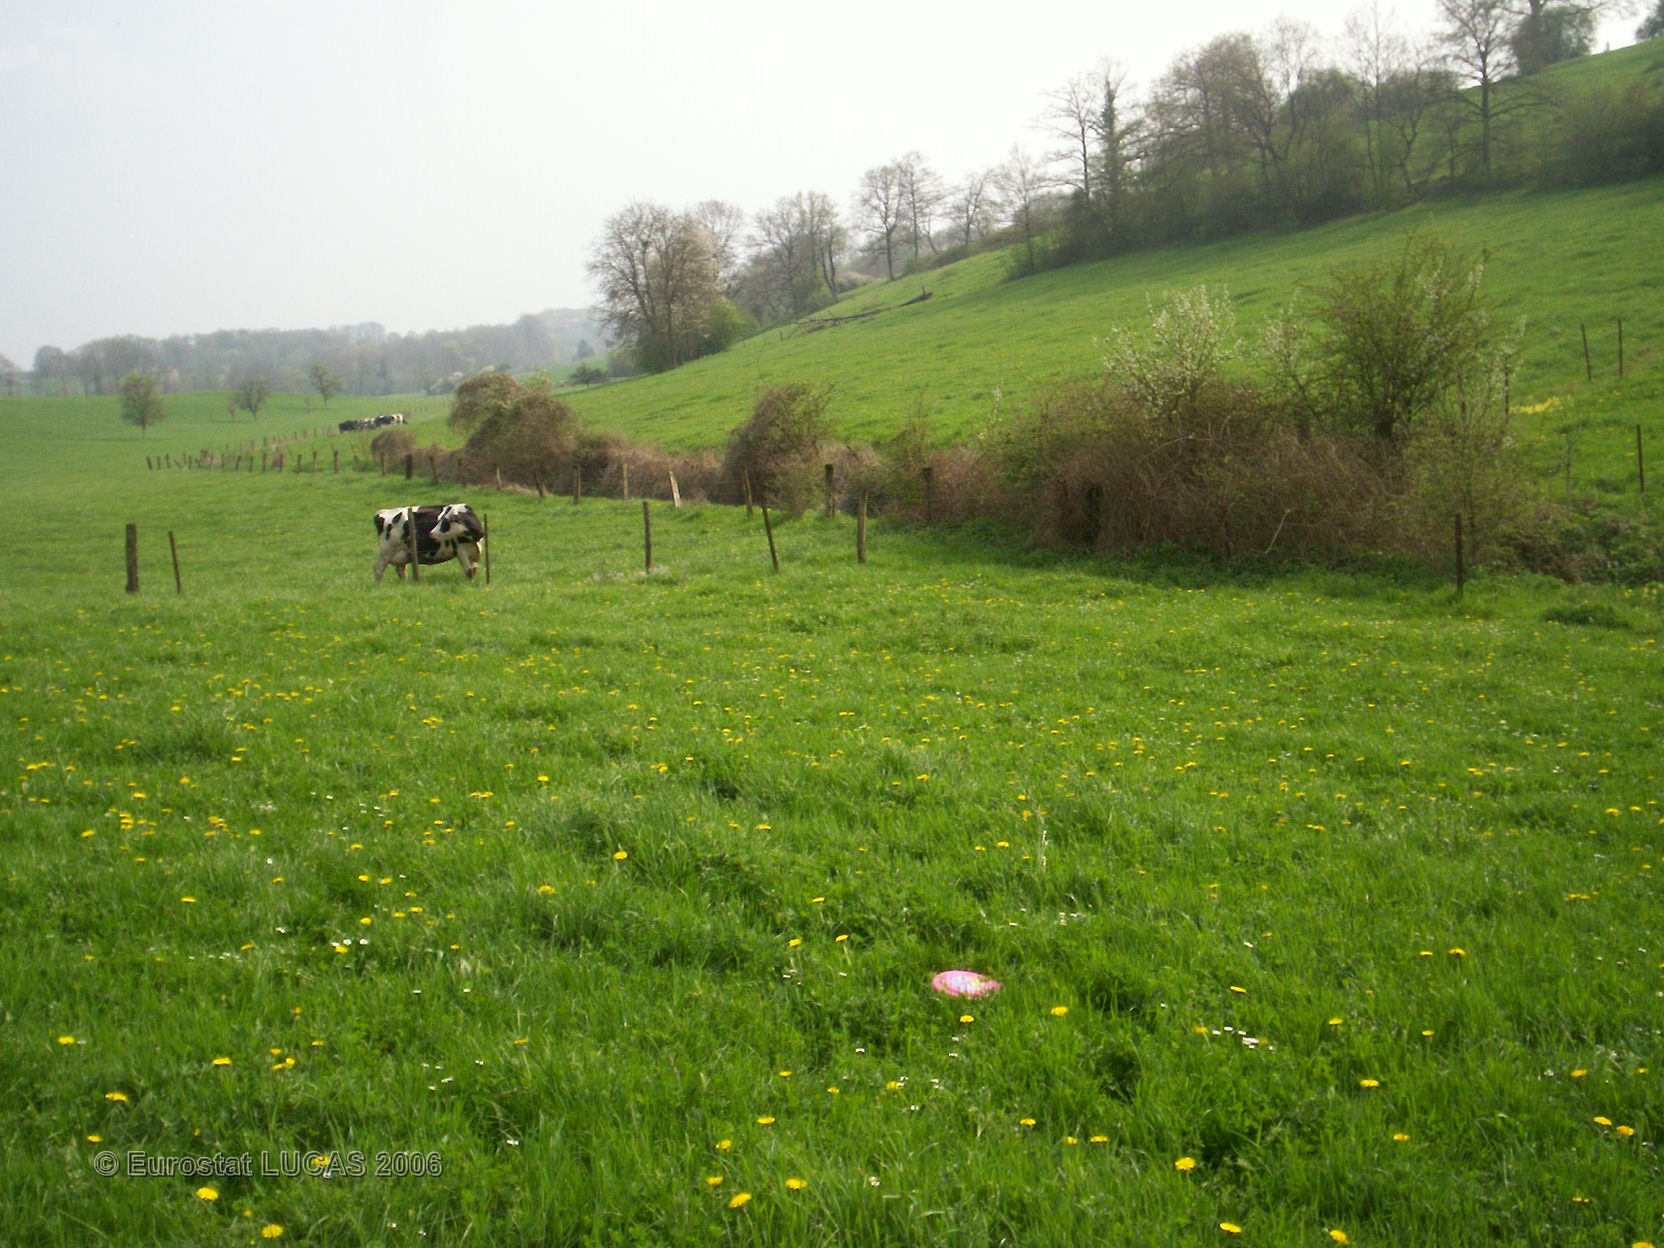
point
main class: Grassland
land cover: Grassland without tree/shrub cover
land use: Agriculture (excluding fallow land and kitchen gardens)
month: April
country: FR
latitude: 49.5679
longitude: 4.5623
